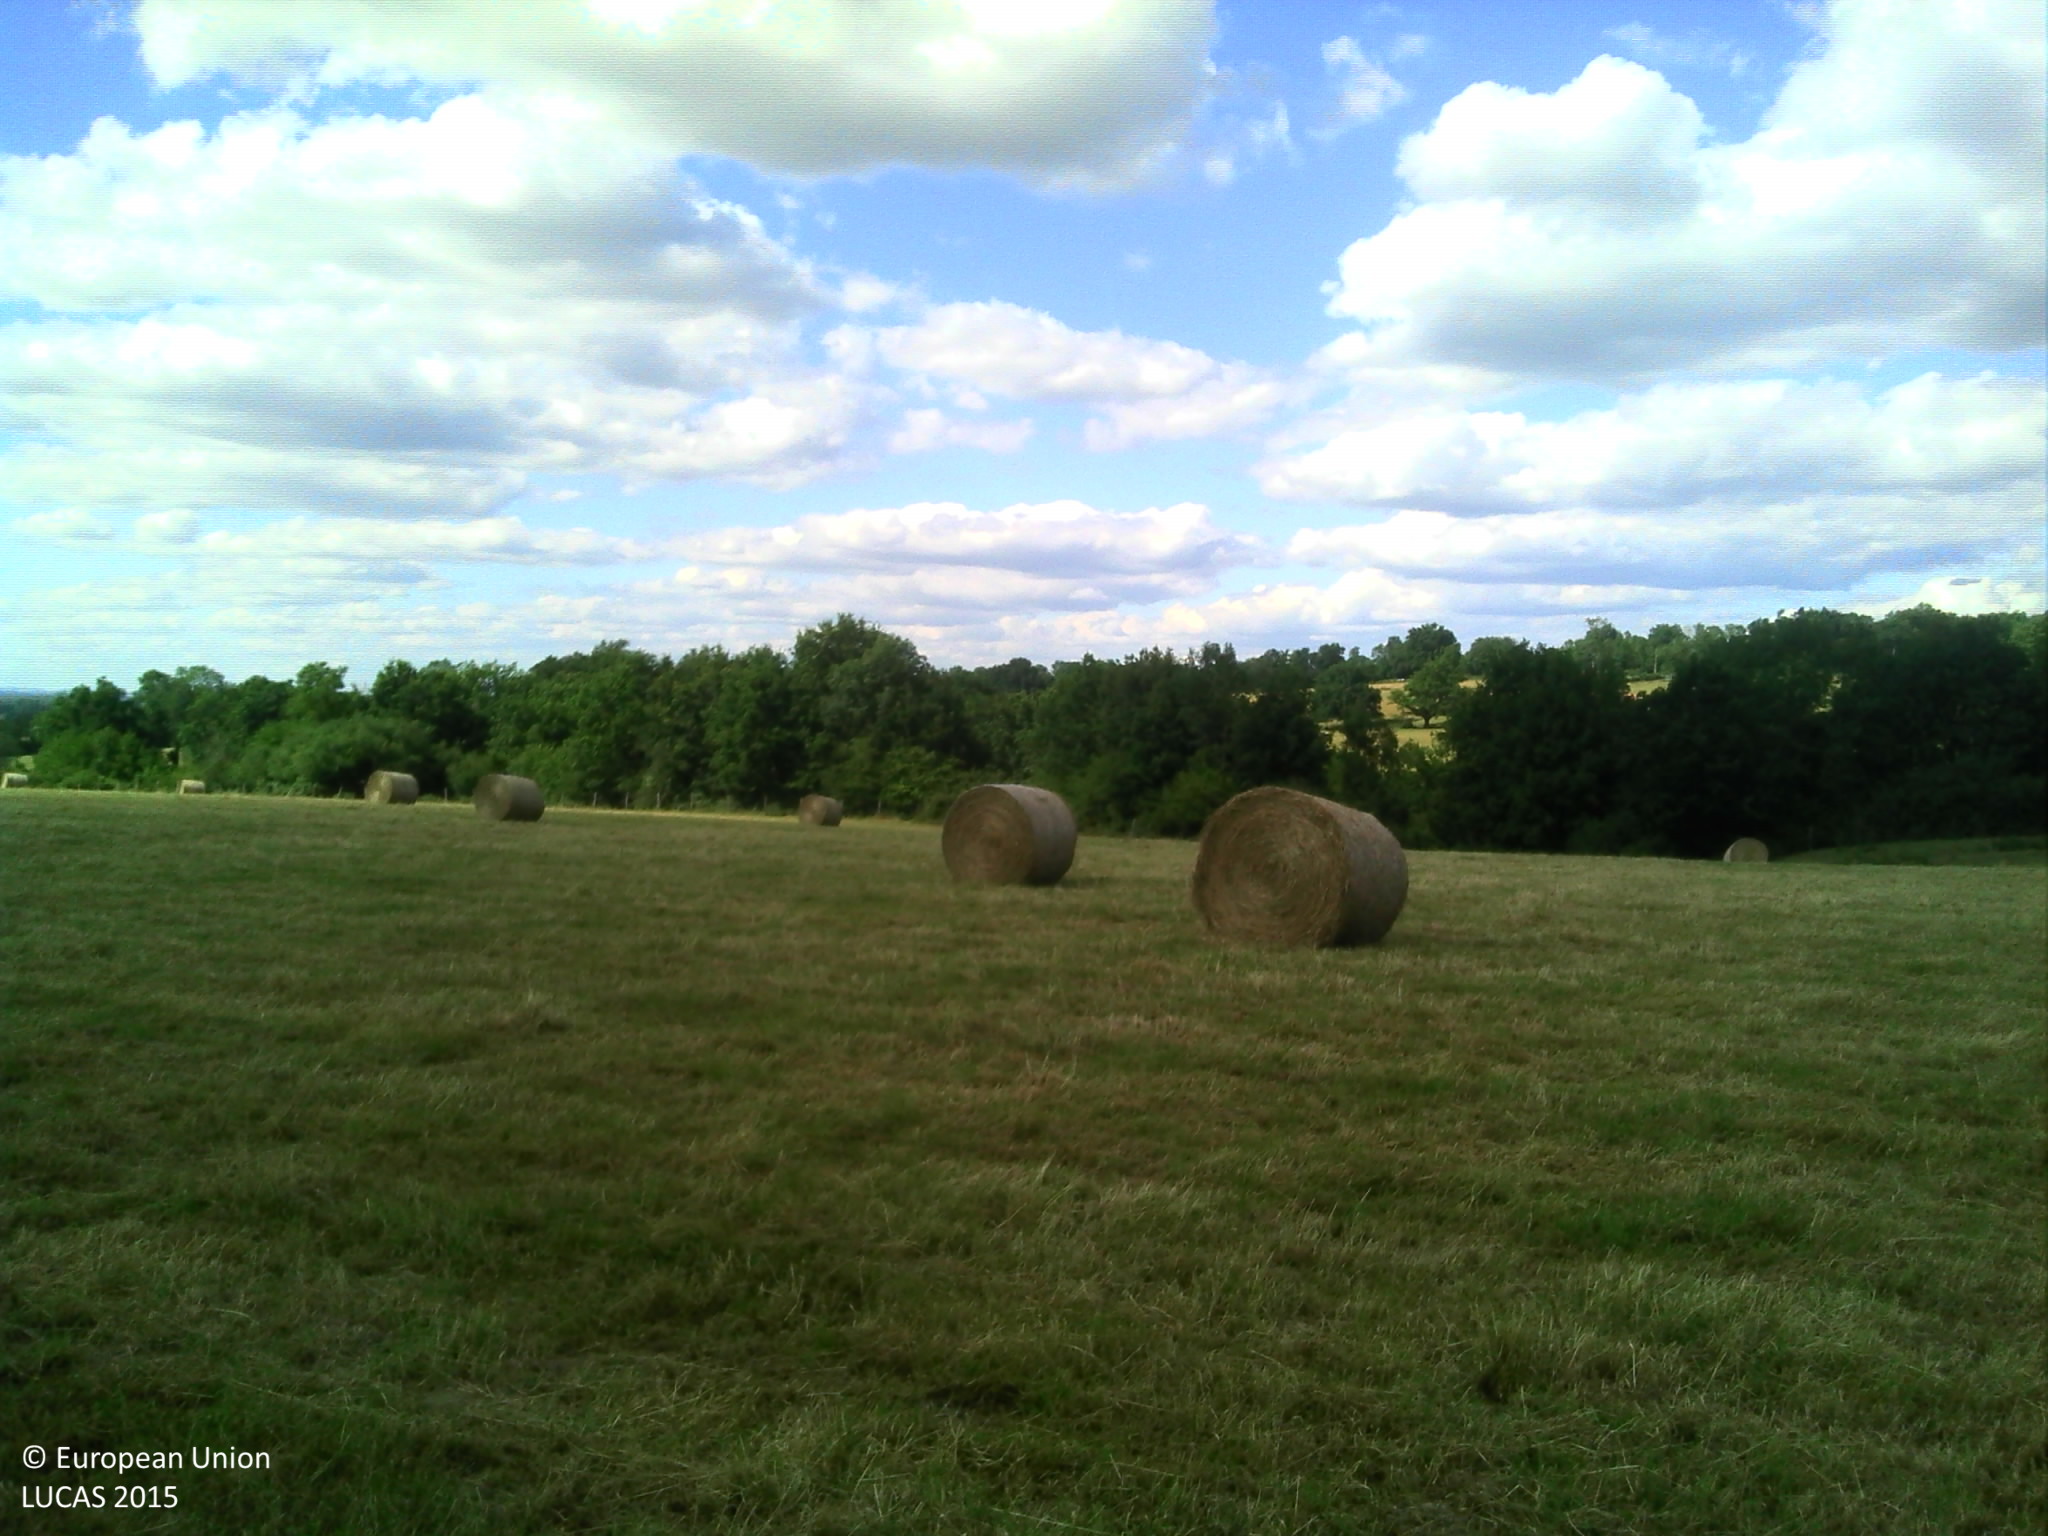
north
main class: Grassland
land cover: Grassland without tree/shrub cover
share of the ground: > 75 %
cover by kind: herbaceous plants 100 %
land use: Agriculture (excluding fallow land and kitchen gardens)
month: June
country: FR
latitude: 46.2397
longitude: 4.0485
